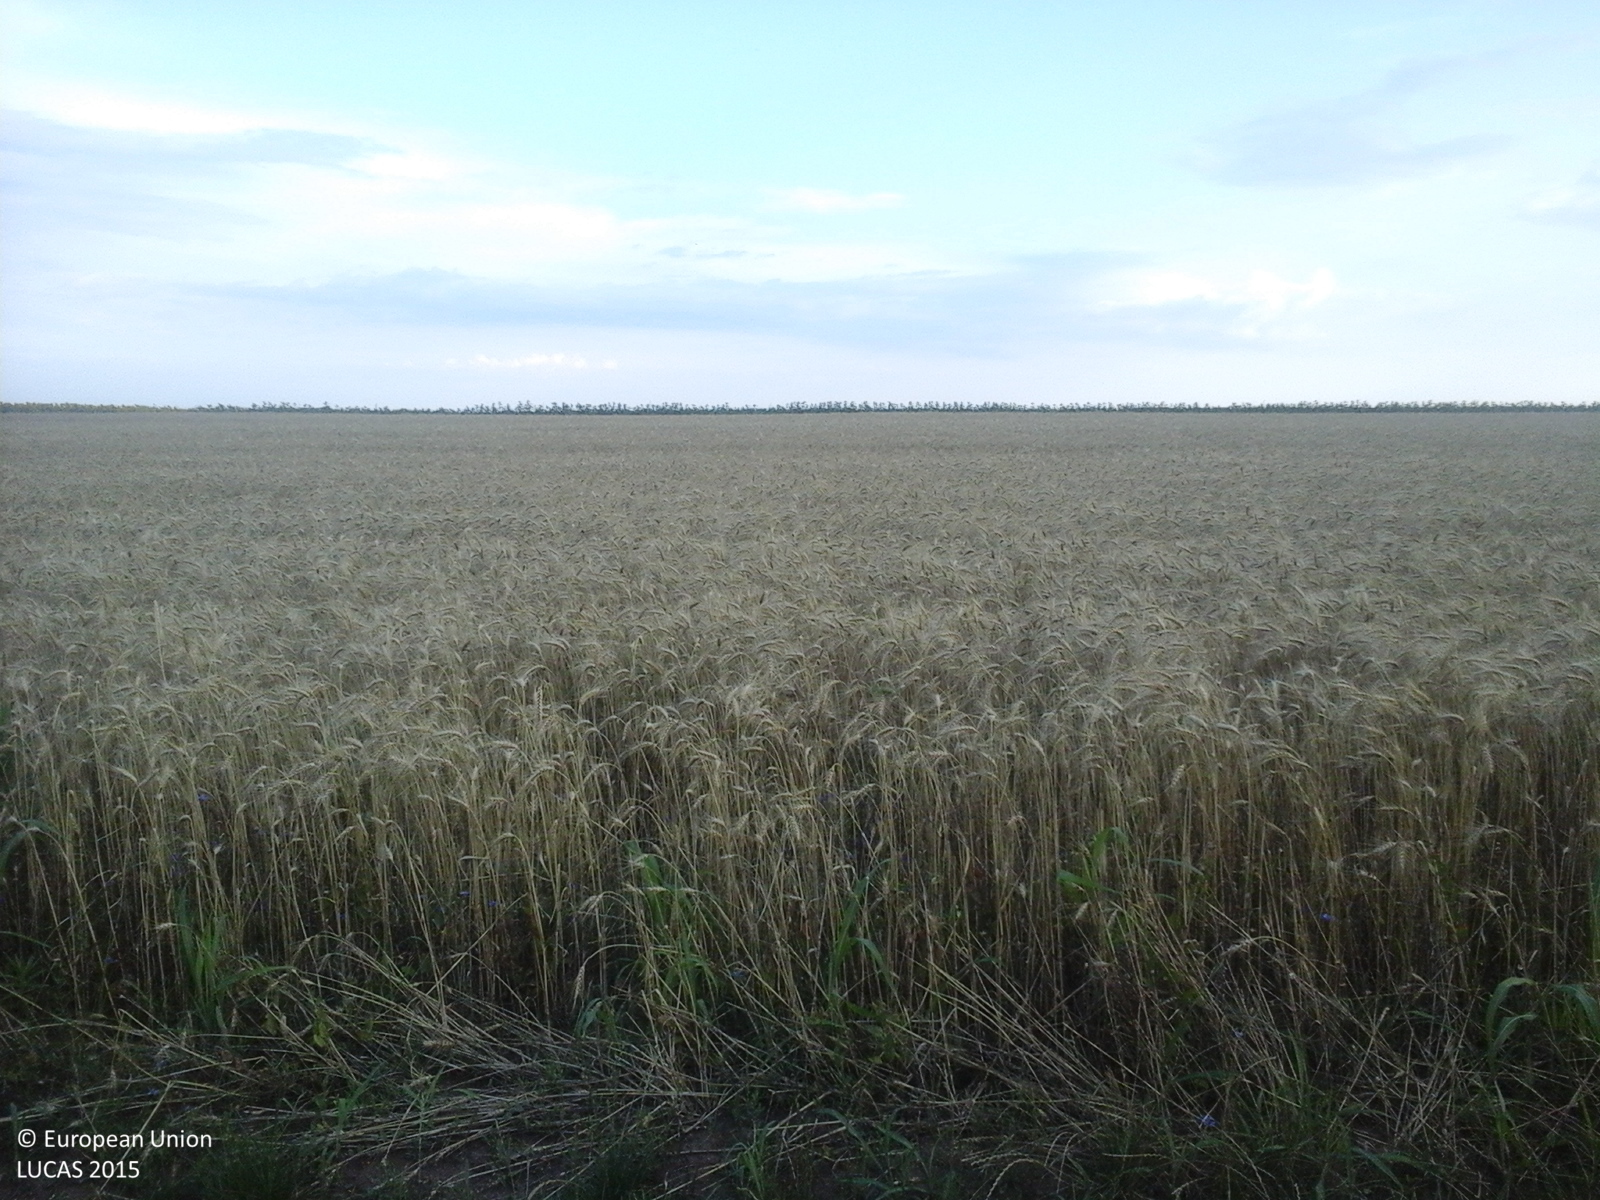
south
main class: Cropland
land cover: Sunflower
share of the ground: > 75 %
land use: Agriculture (excluding fallow land and kitchen gardens)
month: July
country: RO
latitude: 44.0385
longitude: 24.3779
